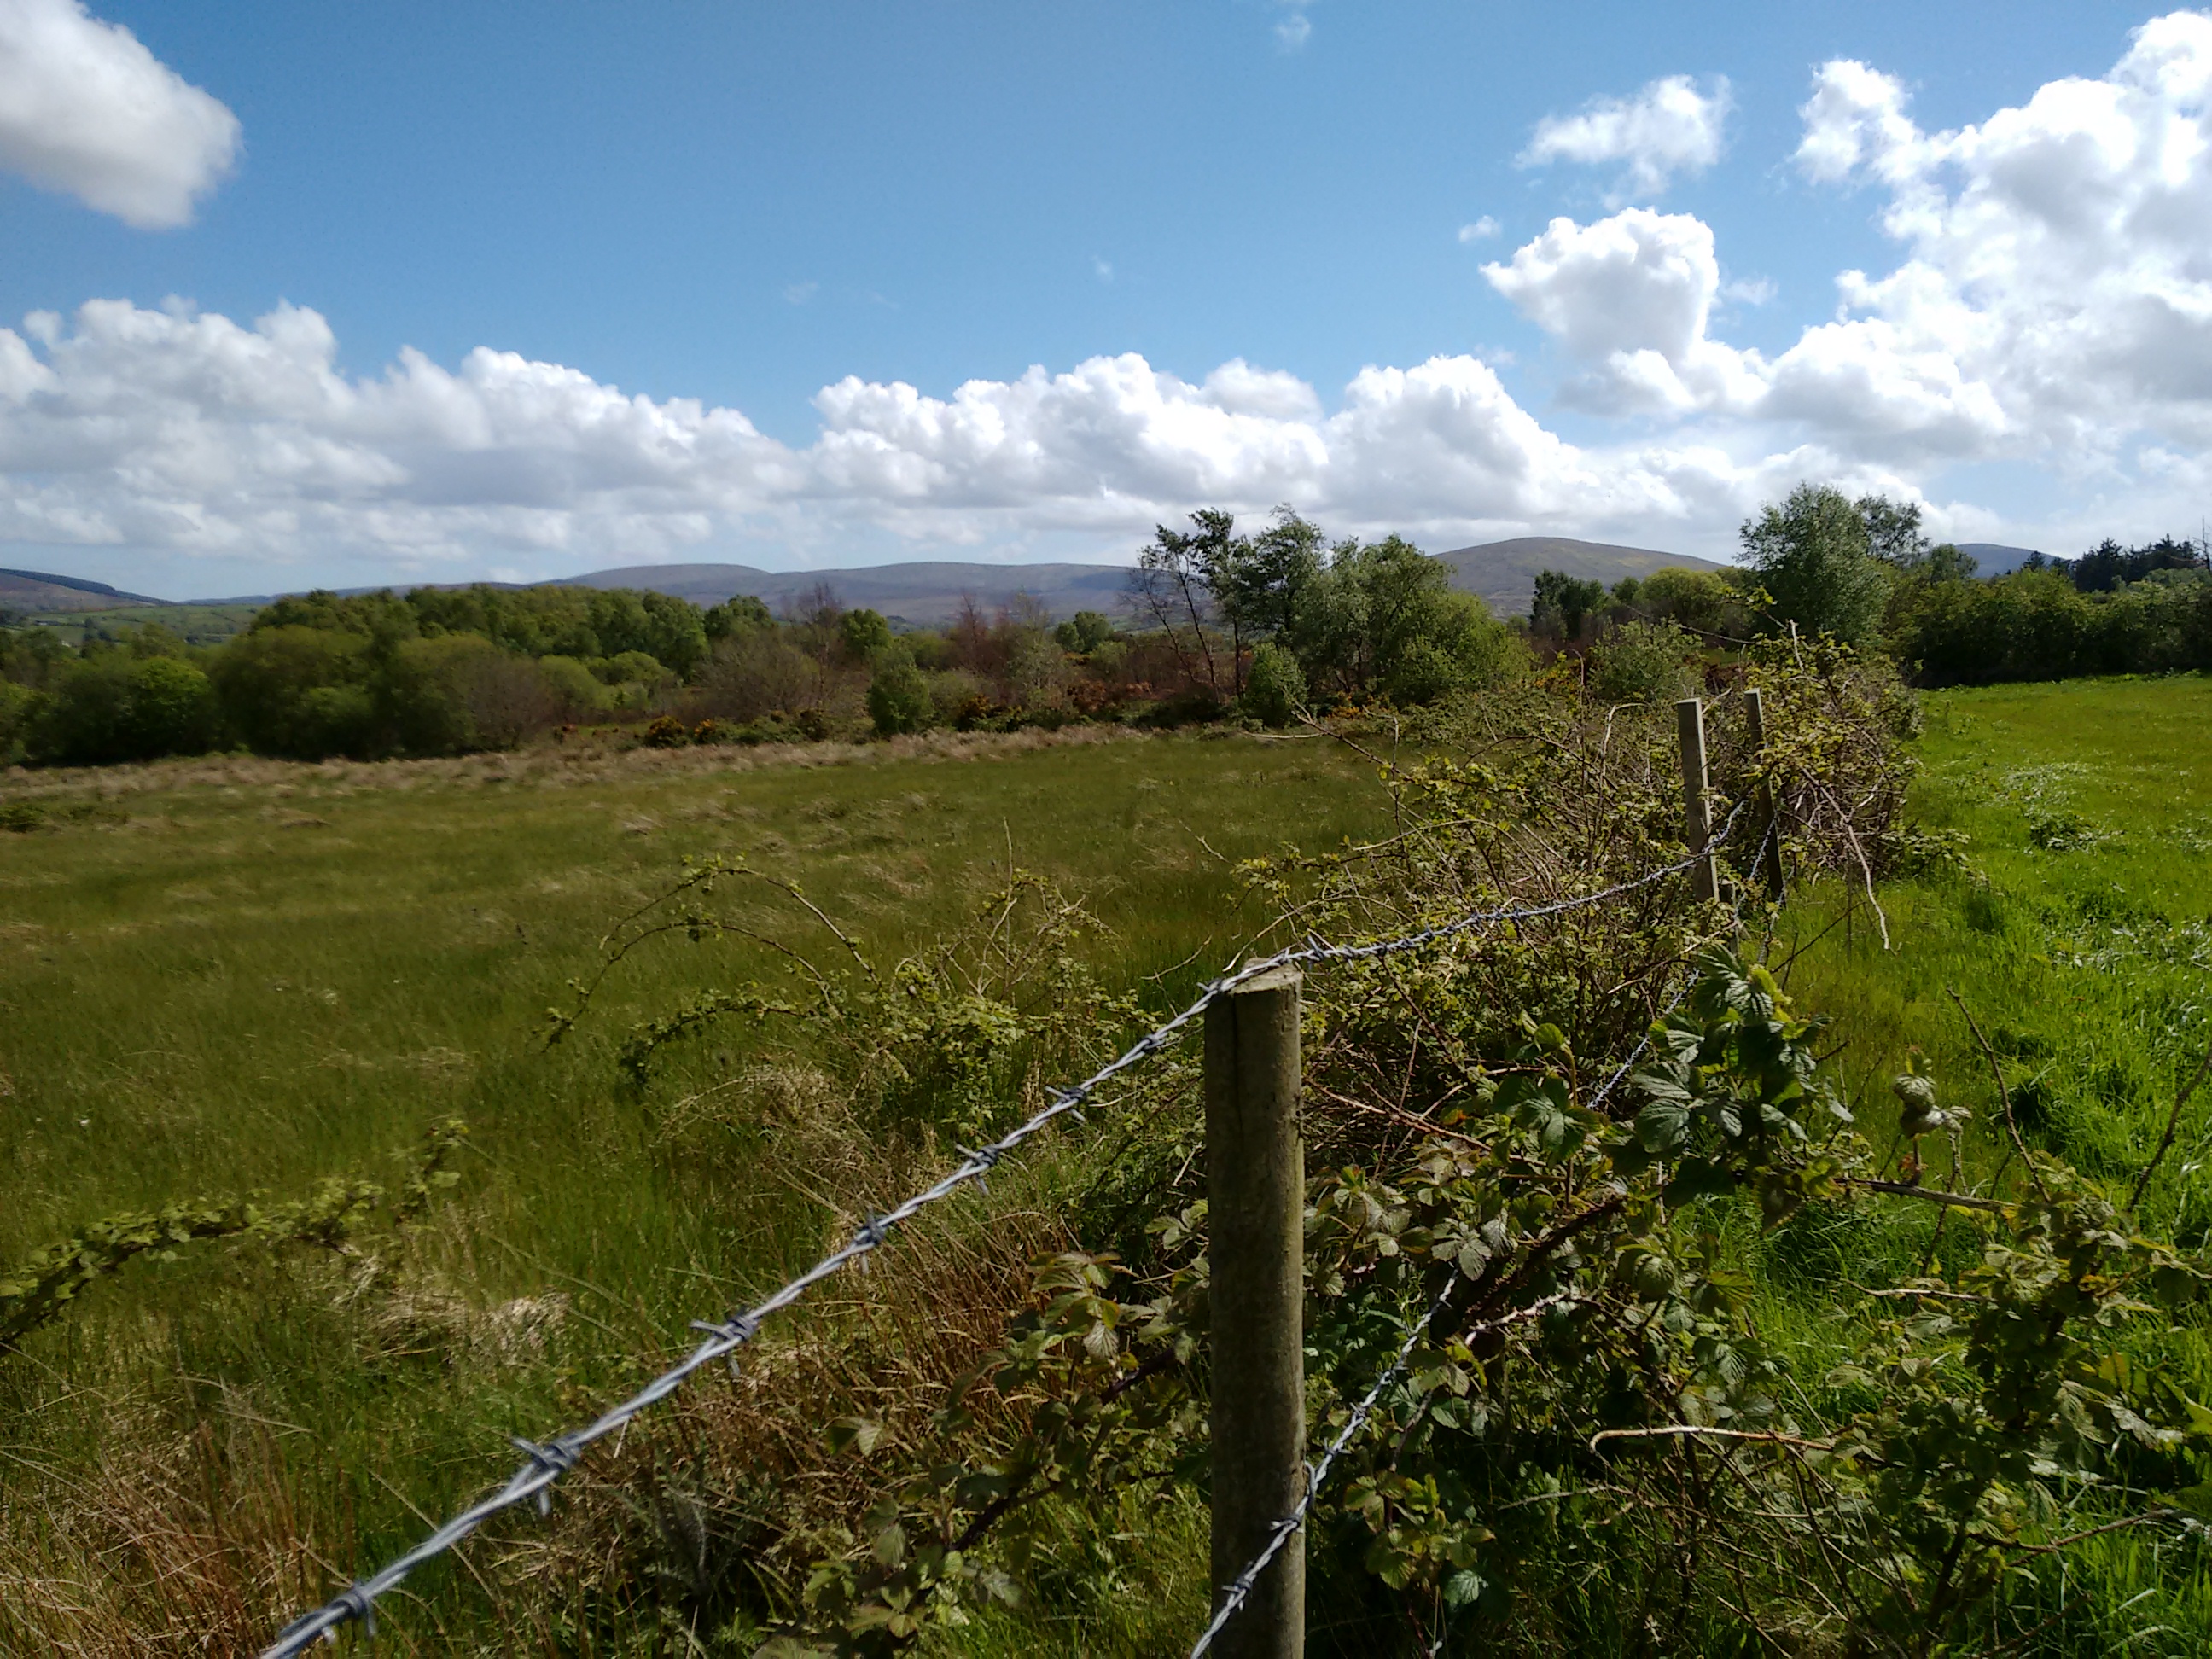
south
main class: Grassland
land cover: Grassland without tree/shrub cover
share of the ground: > 75 %
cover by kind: herbaceous plants 100 %
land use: Agriculture (excluding fallow land and kitchen gardens)
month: June
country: GB
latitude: 54.9114
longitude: -7.0003
